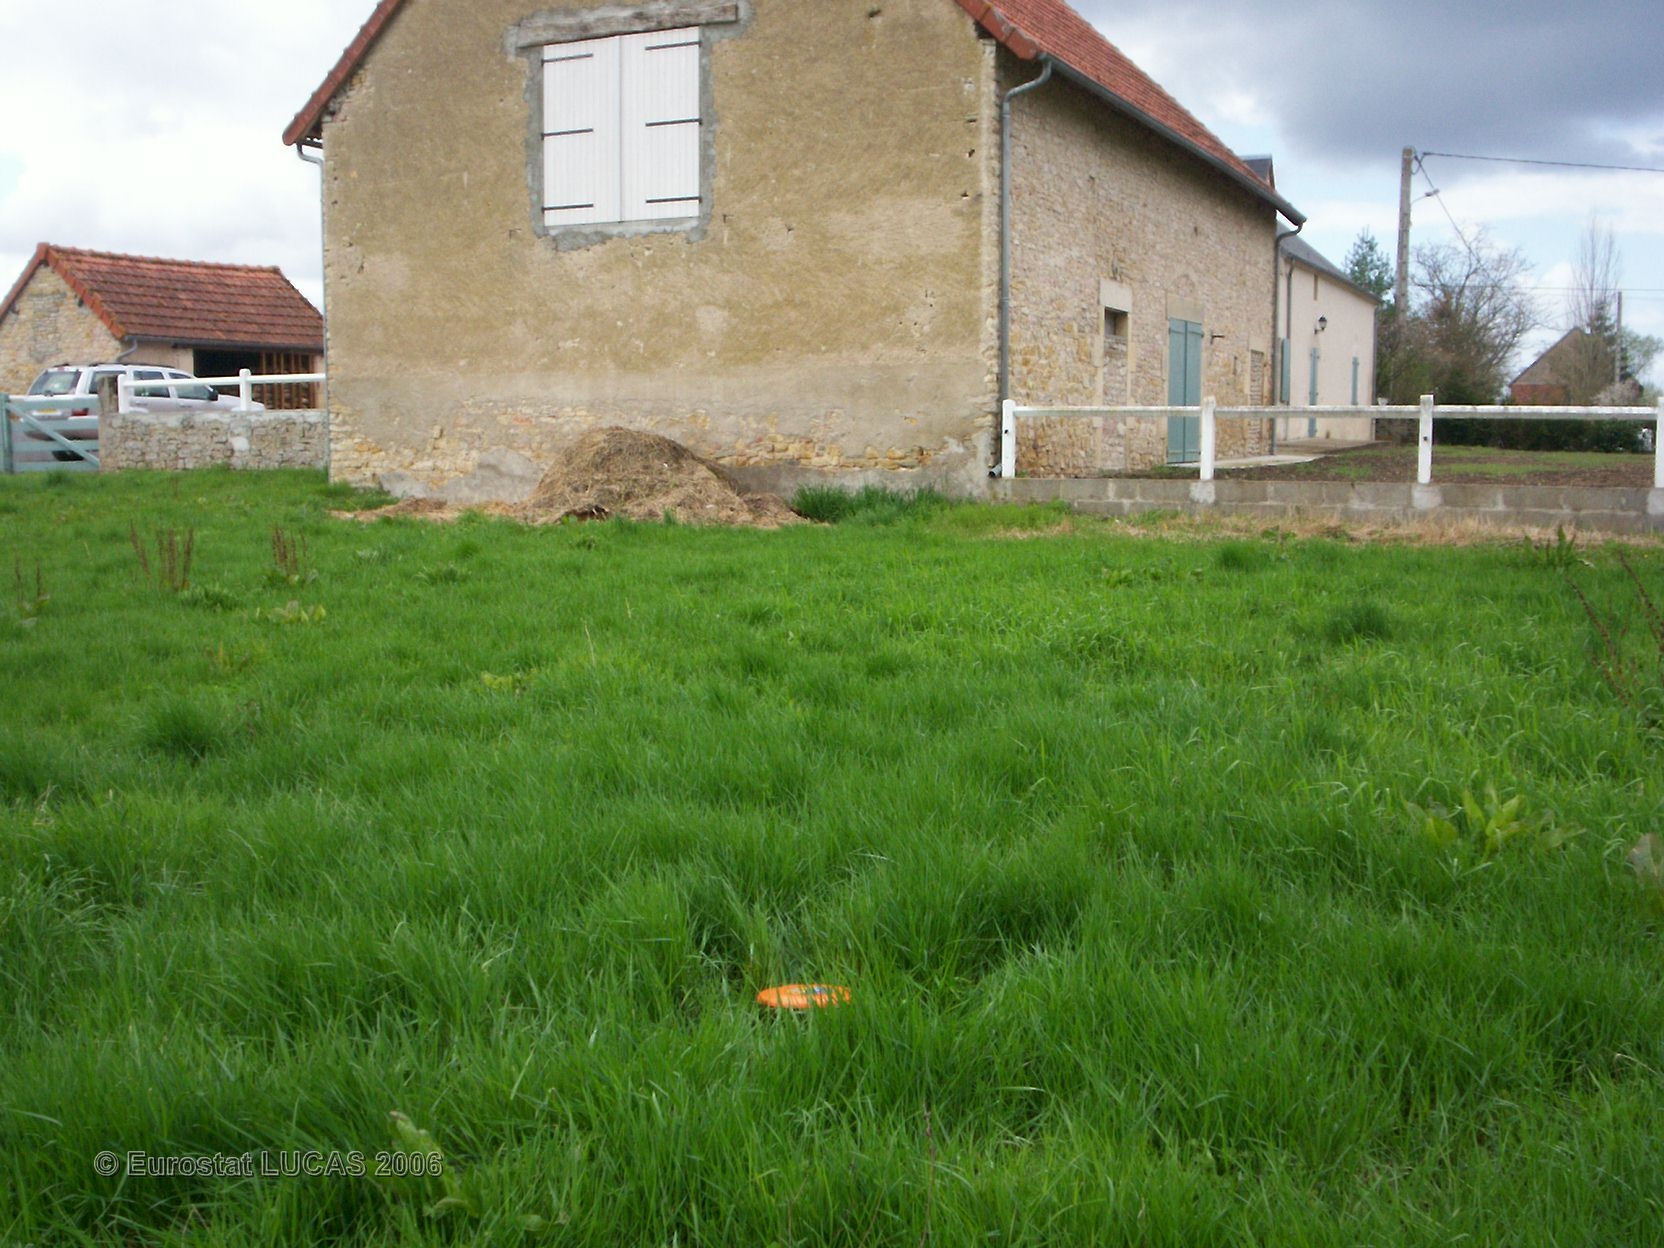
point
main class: Grassland
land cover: Grassland without tree/shrub cover
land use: Agriculture (excluding fallow land and kitchen gardens)
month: April
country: FR
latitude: 46.8502
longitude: 3.0850
